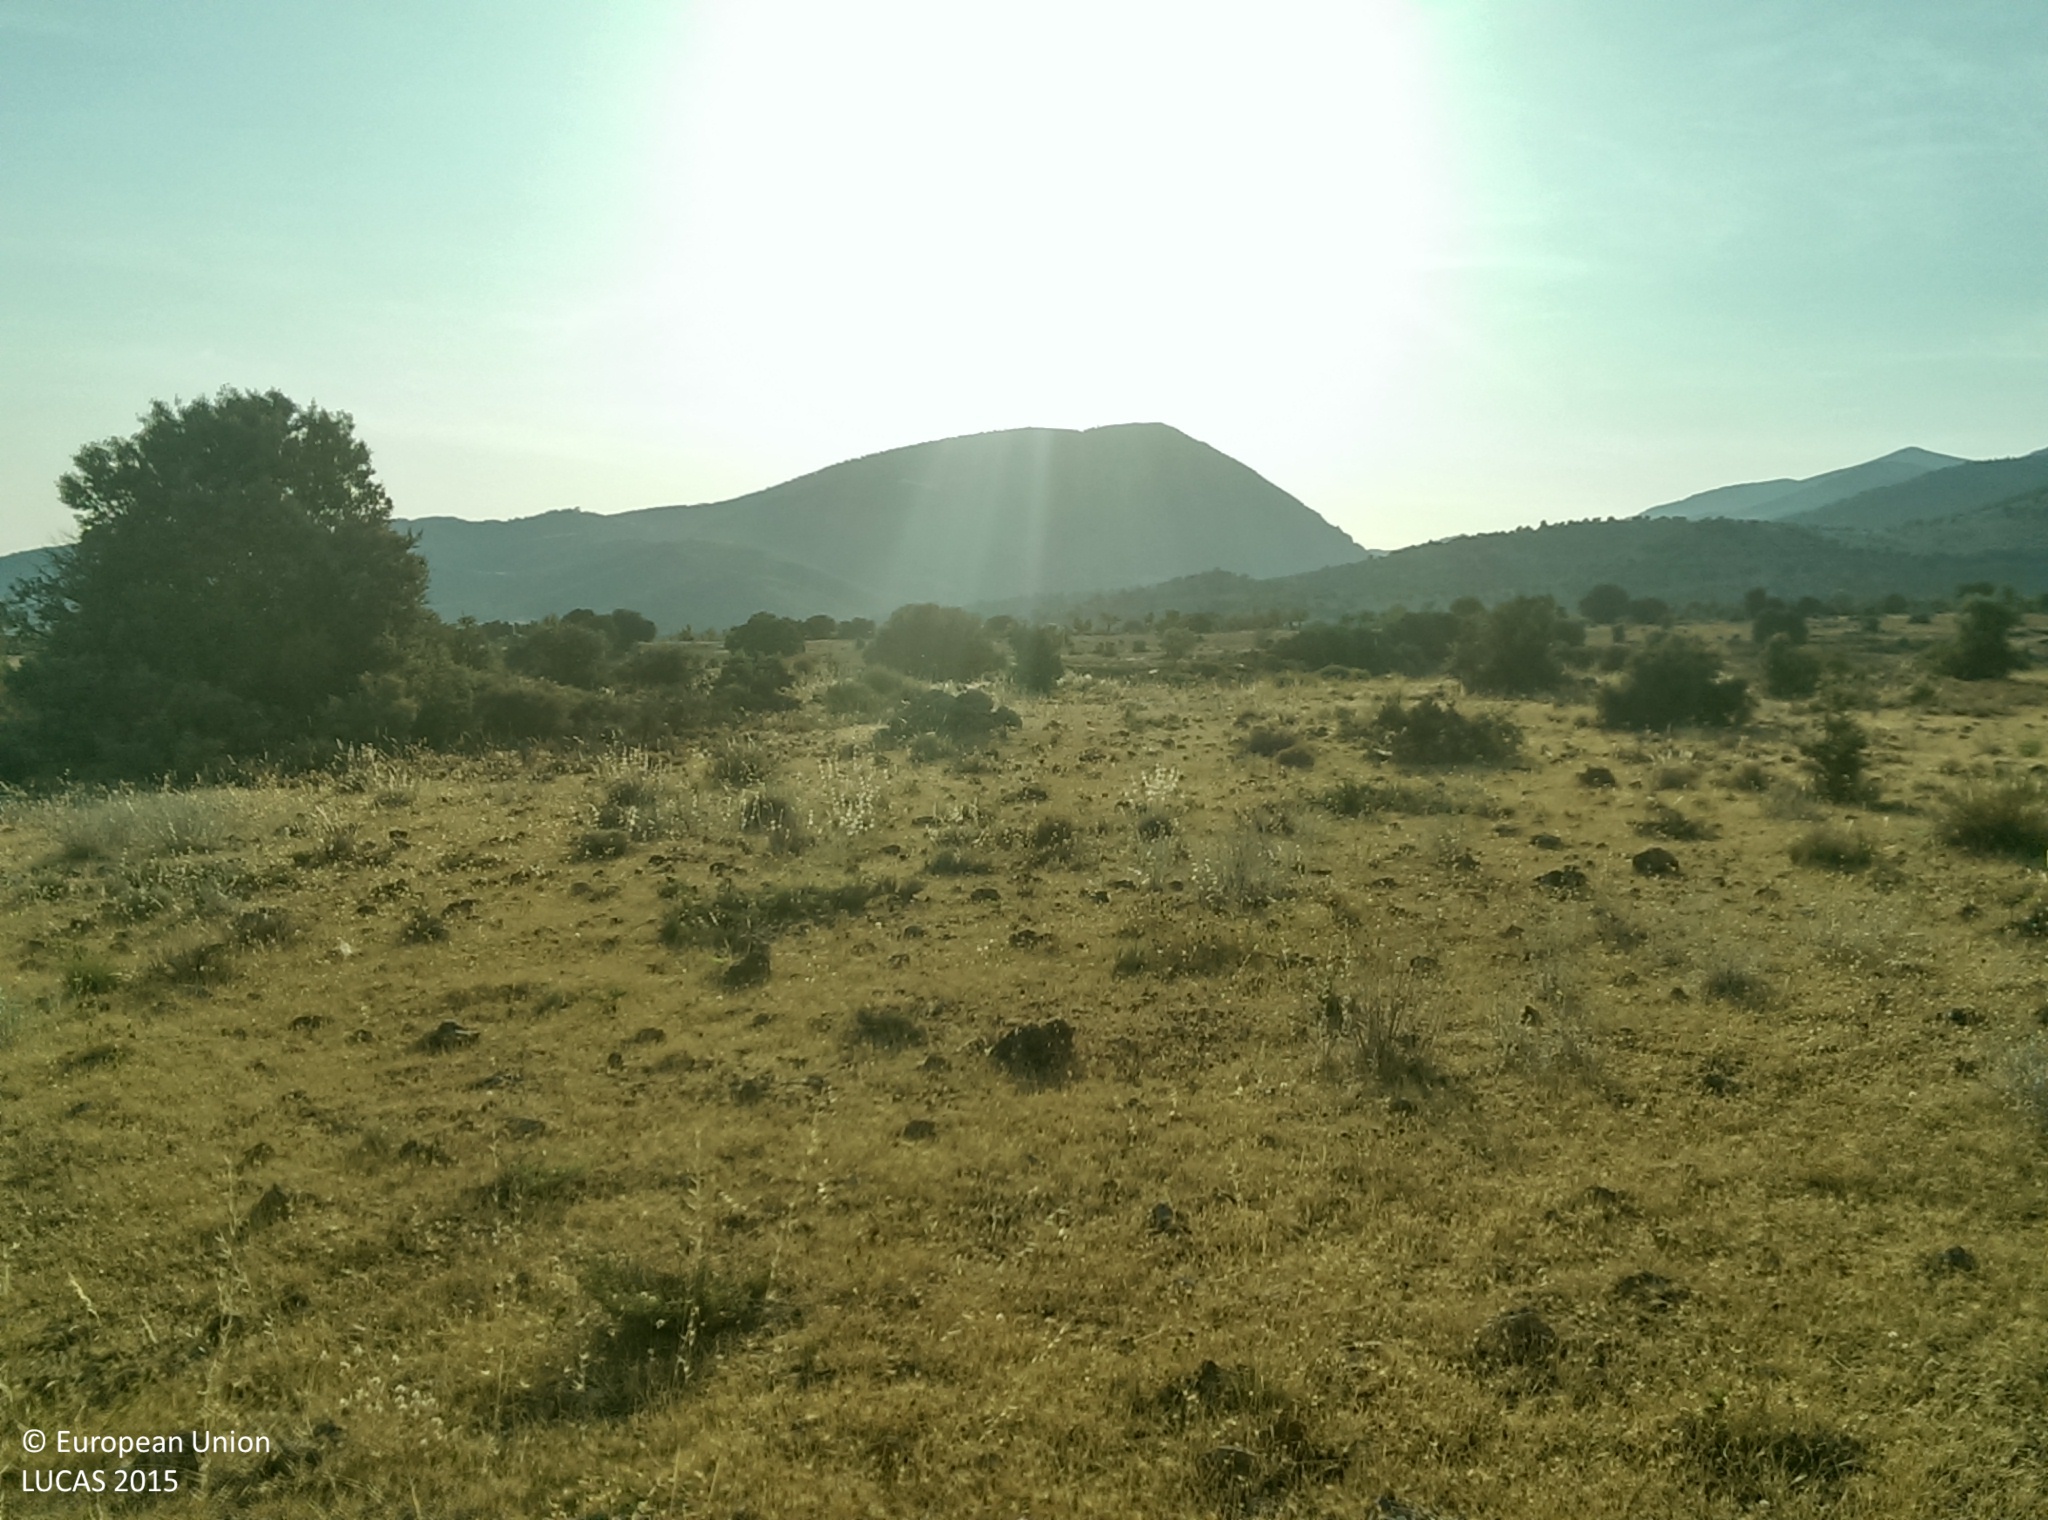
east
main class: Grassland
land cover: Grassland with sparse tree/shrub cover
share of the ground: > 75 %
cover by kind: herbaceous plants 90 %, broadleaved forest trees 5 %, shrubs 5 %
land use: Semi-natural and natural areas not in use
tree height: > 5 m
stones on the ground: > 50 %
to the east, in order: Grassland with sparse tree/shrub cover; Rivers and streams; Grassland with sparse tree/shrub cover; Rivers and streams; Grassland with sparse tree/shrub cover
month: July
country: ES
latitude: 37.3910
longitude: -2.9424
